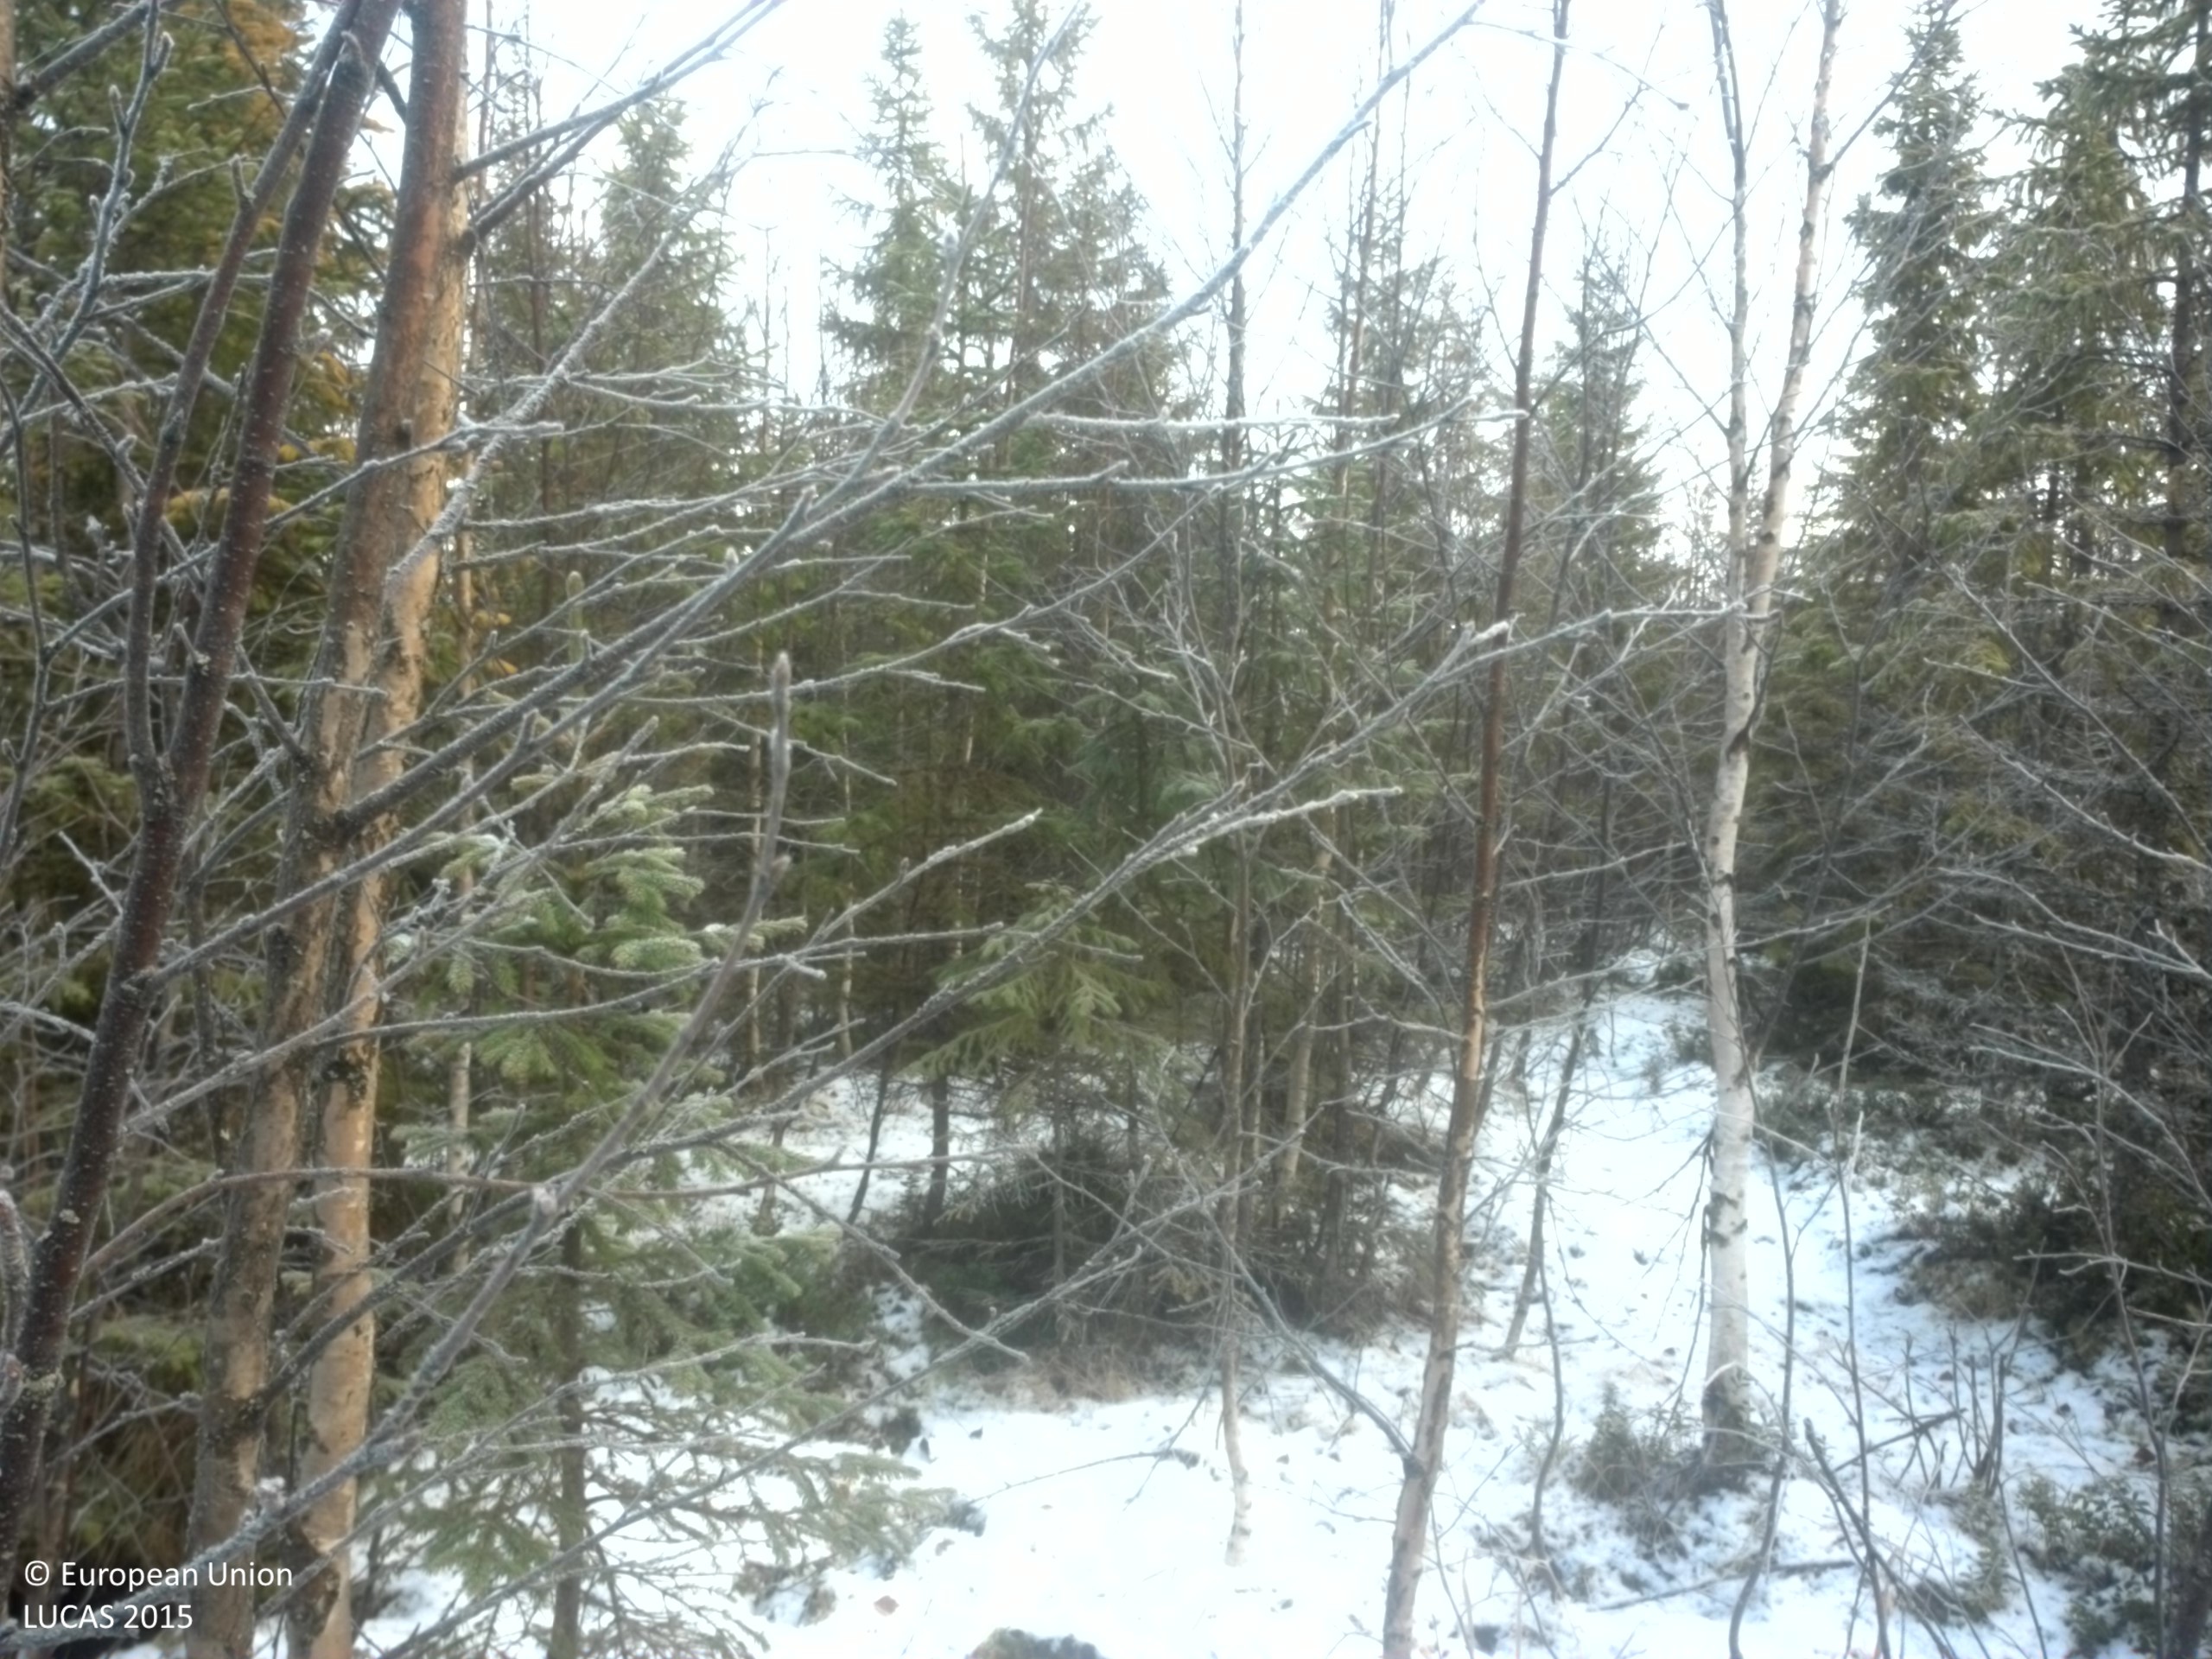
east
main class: Woodland
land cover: Spruce dominated mixed woodland
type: boreal forest
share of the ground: 50 - 75 %
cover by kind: coniferous forest trees 35 %, shrubs 25 %, broadleaved forest trees 15 %, lichens and mosses 15 %, herbaceous plants 10 %
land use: Forestry
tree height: < 5 m
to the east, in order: Spruce dominated mixed woodland; Broadleaved woodland; Ditches and canals; Shruby margins; Tracks; Shruby margins; Spruce dominated mixed woodland; Shruby margins; Tracks; Shruby margins; Spruce dominated mixed woodland
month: November
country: SE
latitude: 63.9050
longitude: 15.9833
